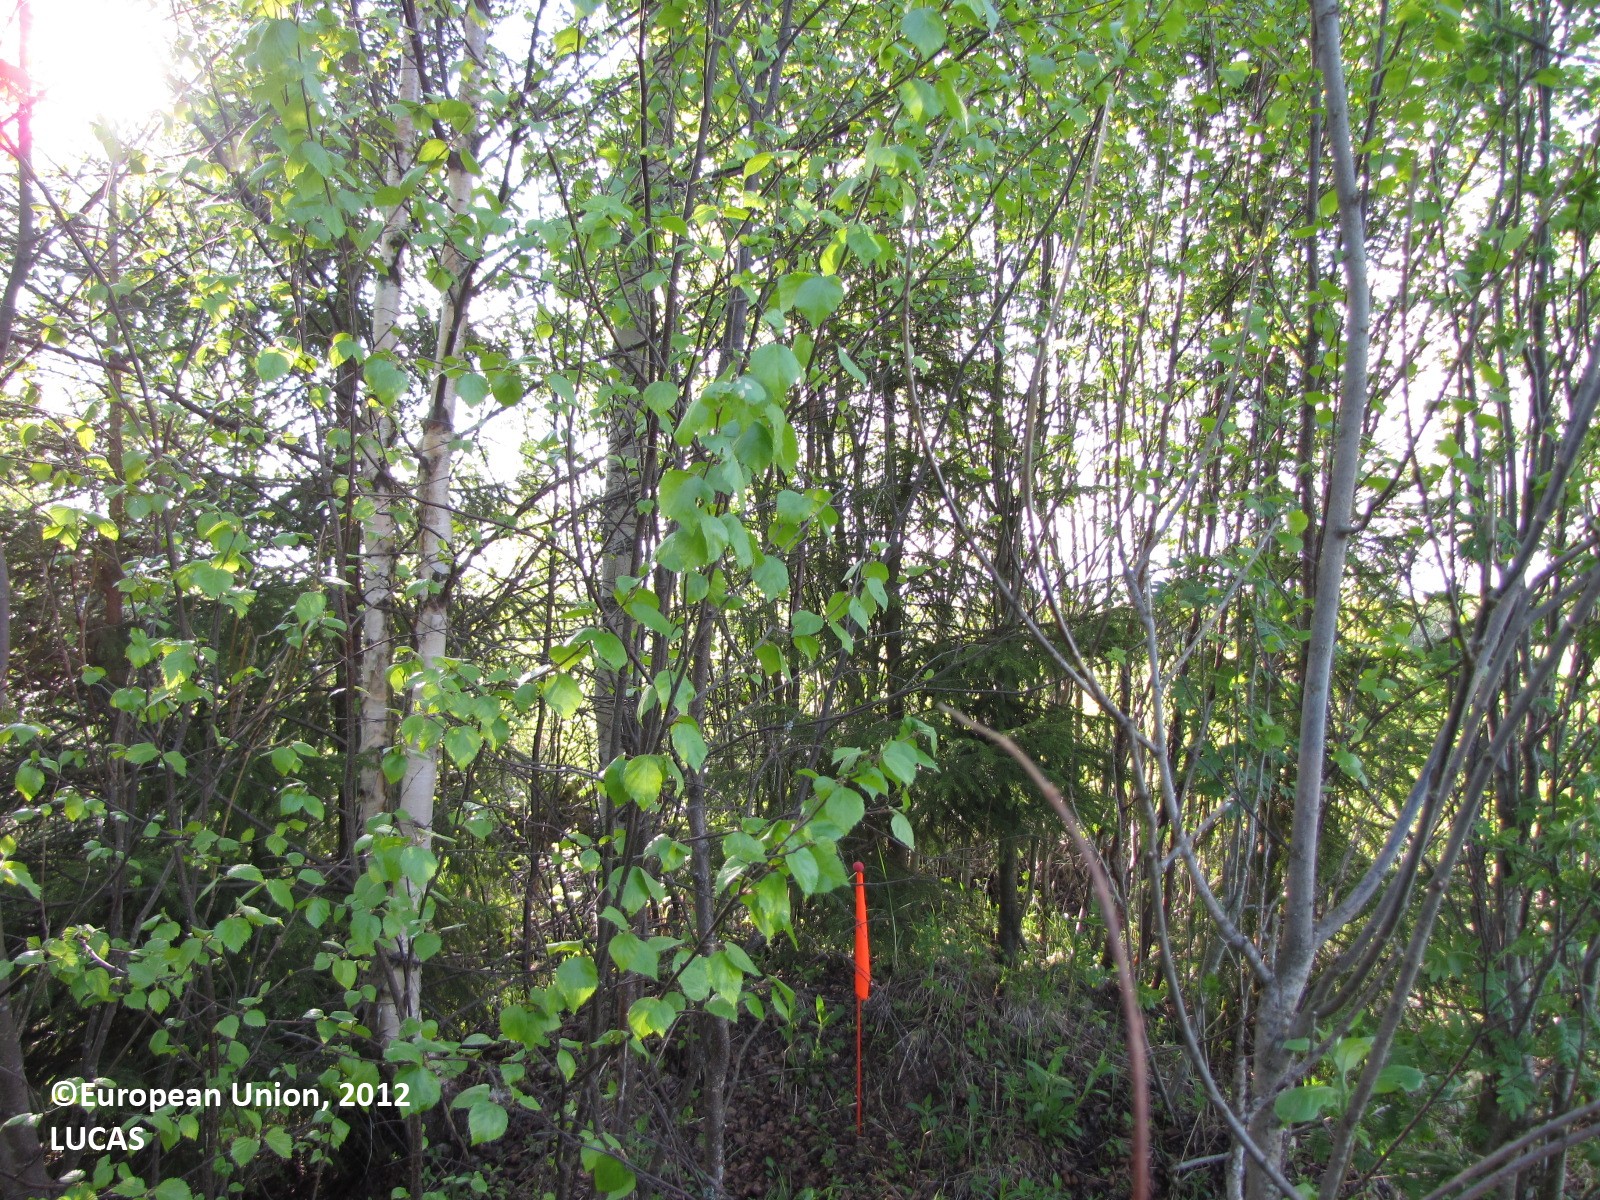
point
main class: Woodland
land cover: Spruce dominated coniferous woodland
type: boreal forest
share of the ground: > 75 %
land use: Forestry
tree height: > 5 m
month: June
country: FI
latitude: 65.8935
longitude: 24.1998
